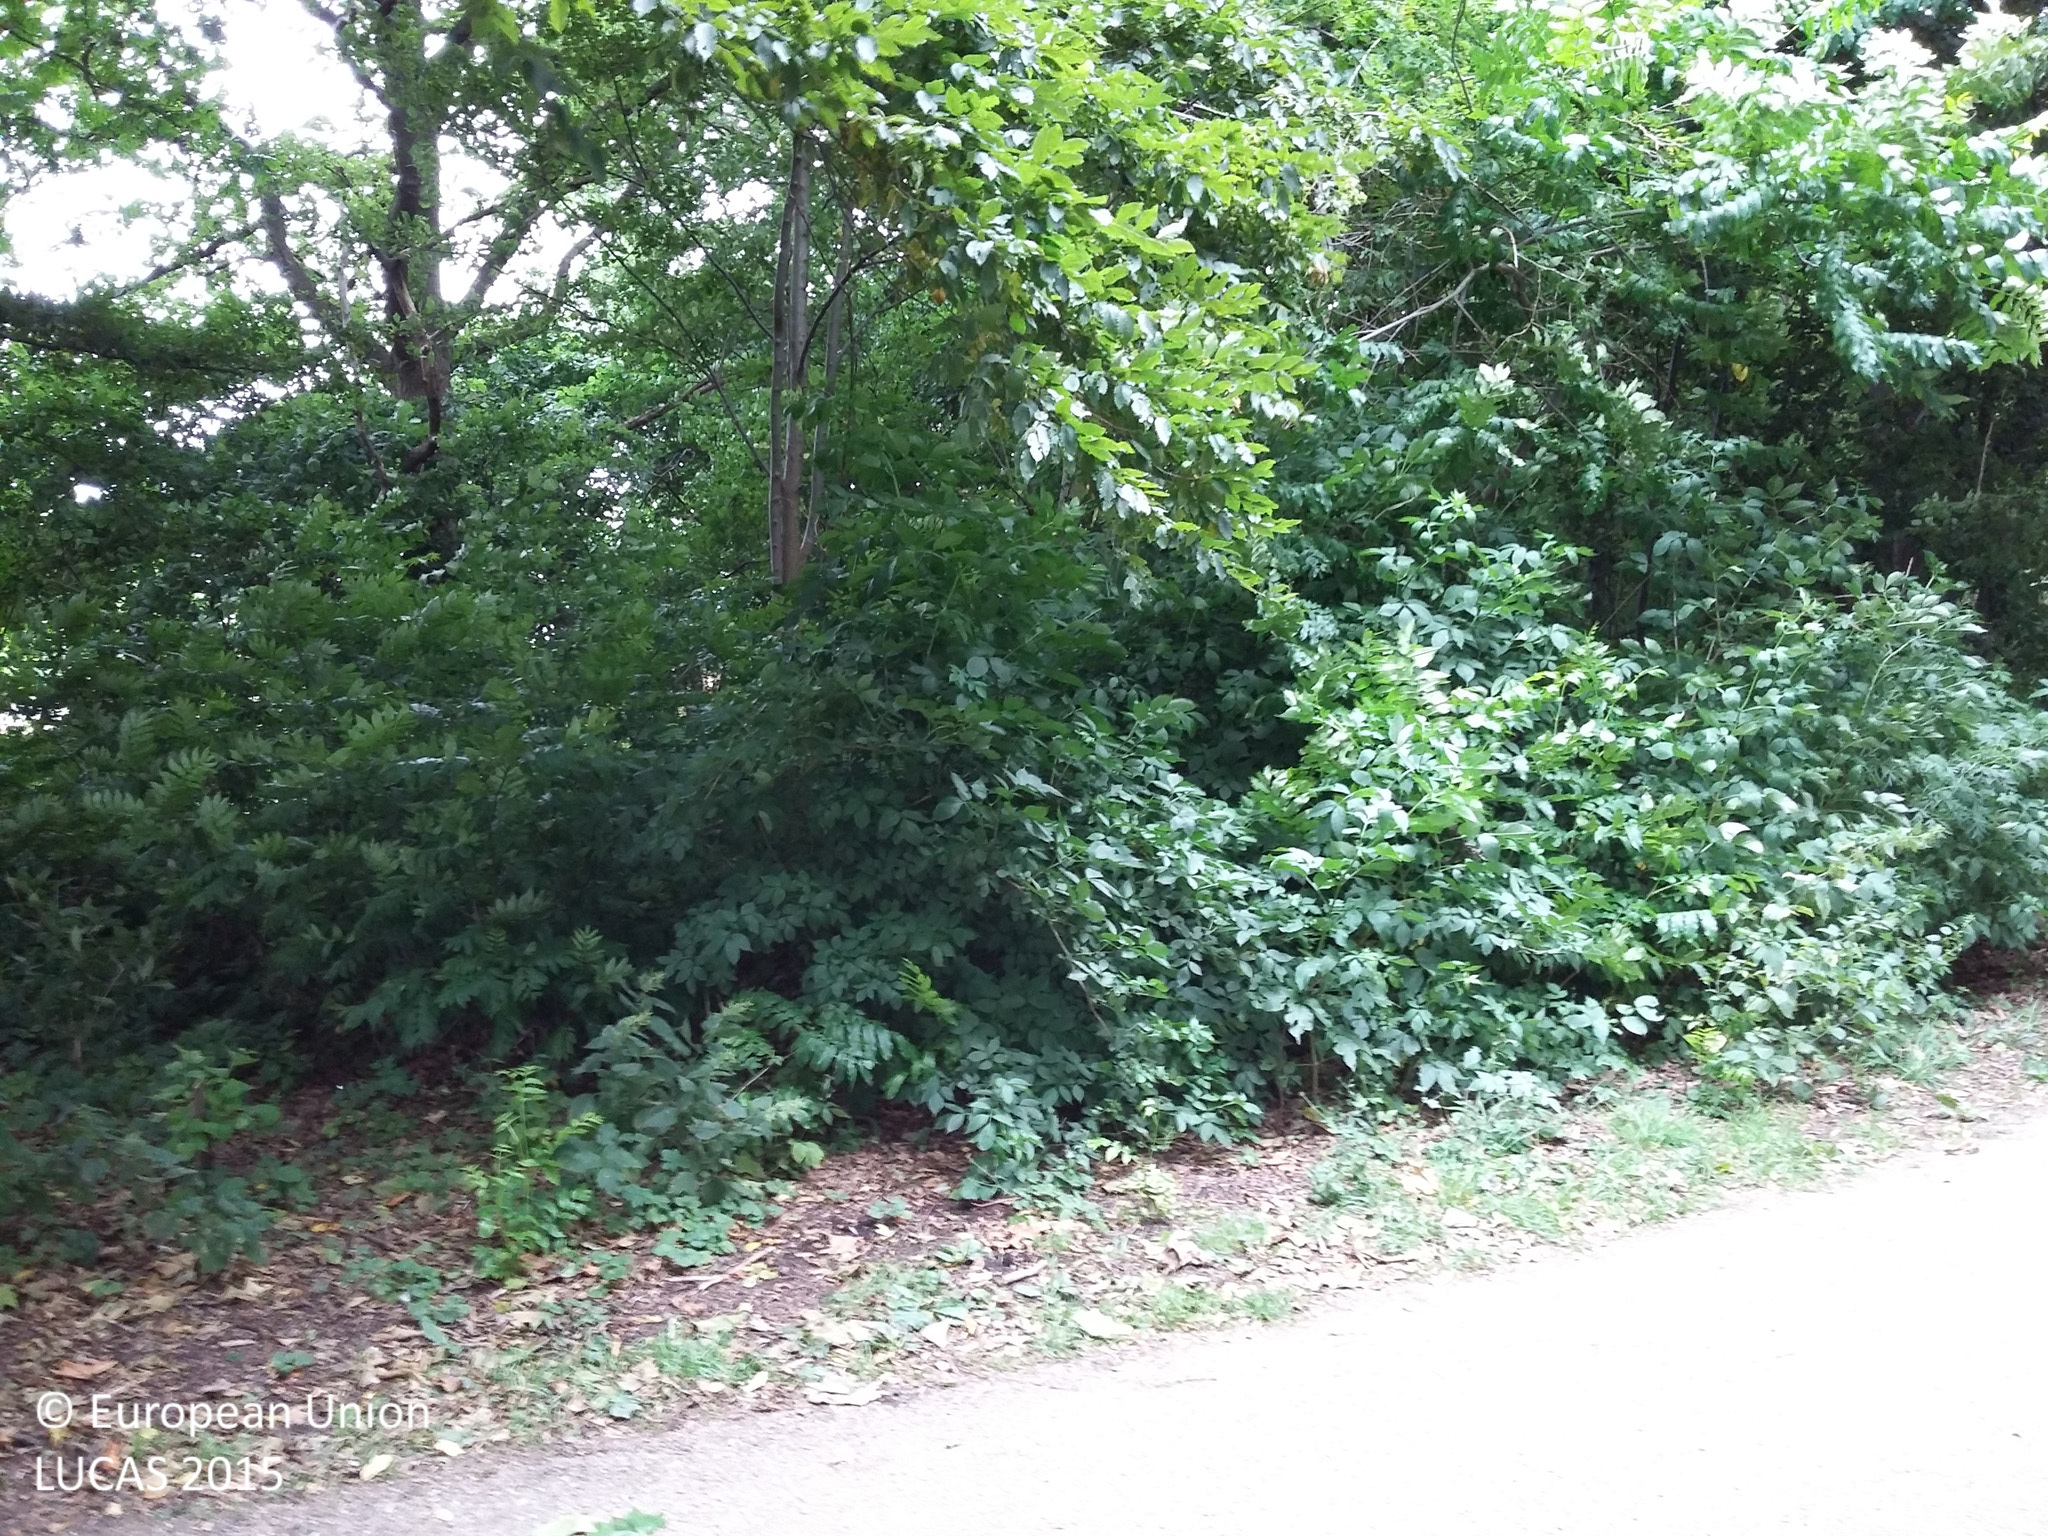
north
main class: Woodland
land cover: Broadleaved woodland
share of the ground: > 75 %
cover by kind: broadleaved forest trees 70 %, herbaceous plants 30 %
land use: Amenities, museums, leisure
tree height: > 5 m
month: July
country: DK
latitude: 55.6414
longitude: 12.5242
